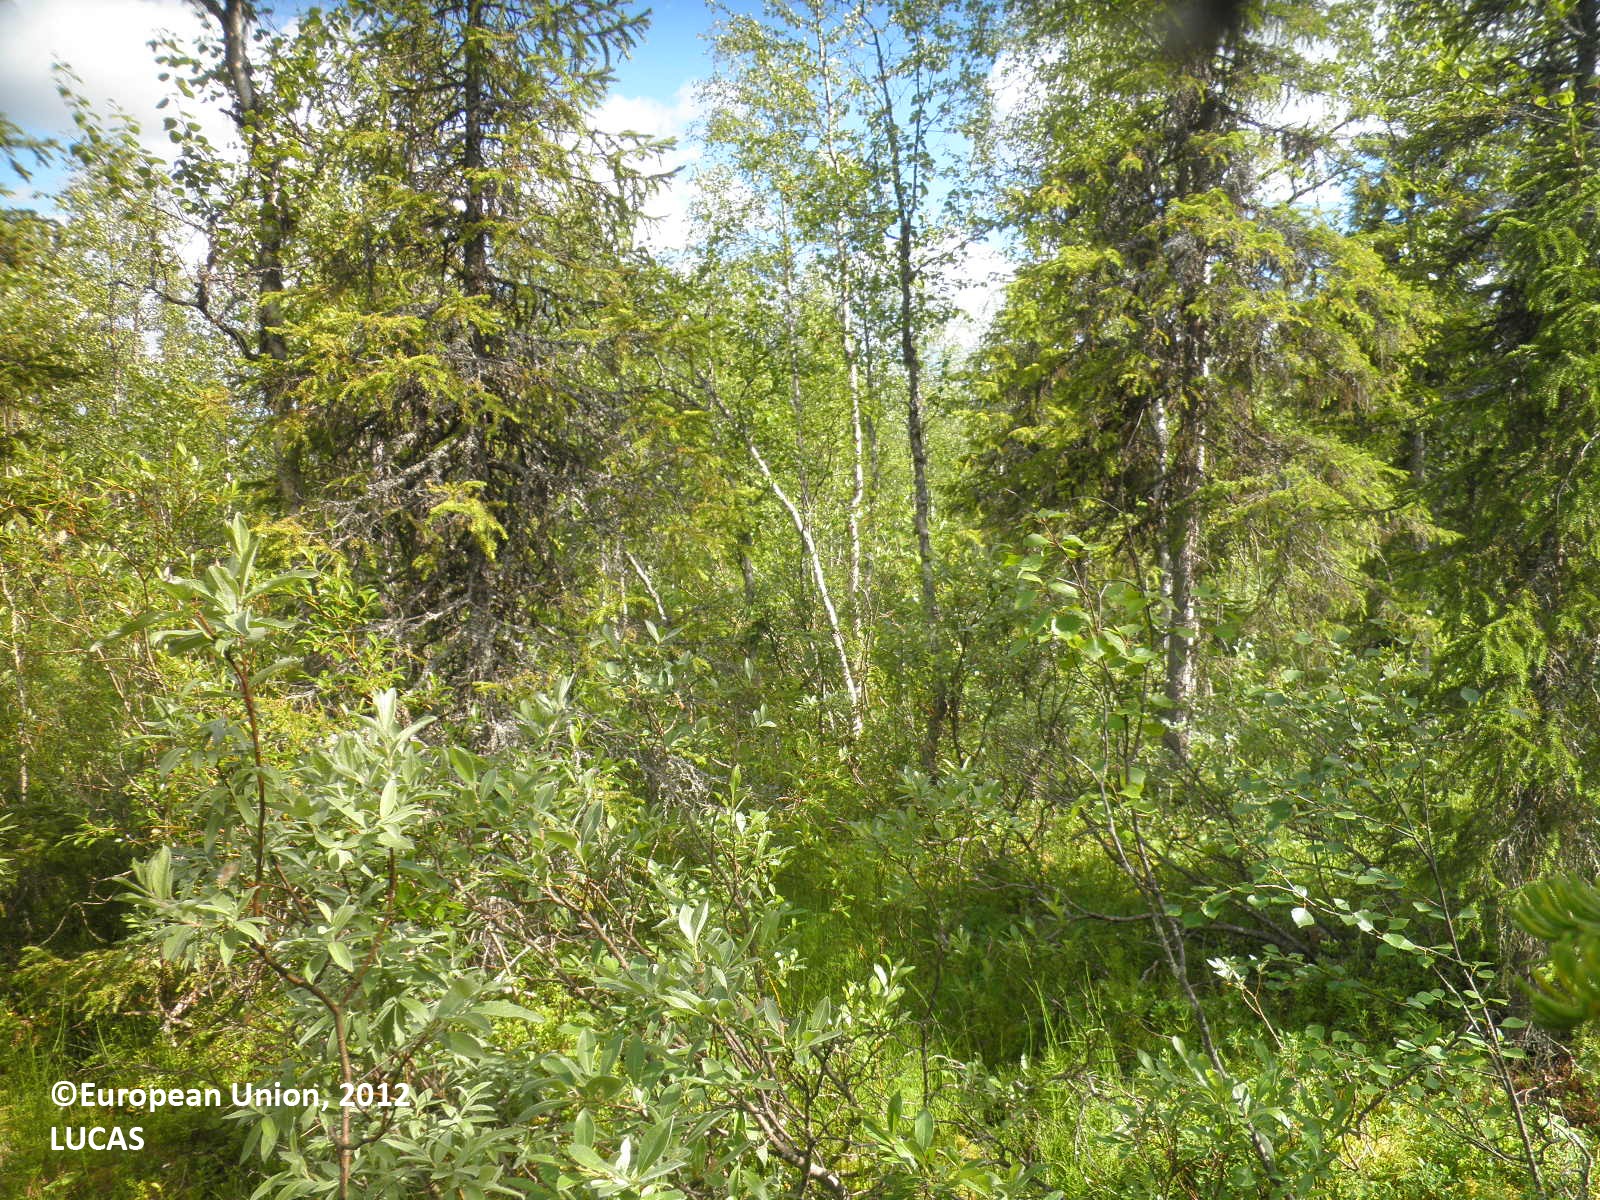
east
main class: Woodland
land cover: Spruce dominated mixed woodland
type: boreal forest
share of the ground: 50 - 75 %
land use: Forestry
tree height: > 5 m
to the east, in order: Spruce dominated mixed woodland; Rivers and streams; Spruce dominated mixed woodland; Peatbogs; Pine dominated coniferous woodland
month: July
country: FI
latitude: 67.6191
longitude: 25.8460
